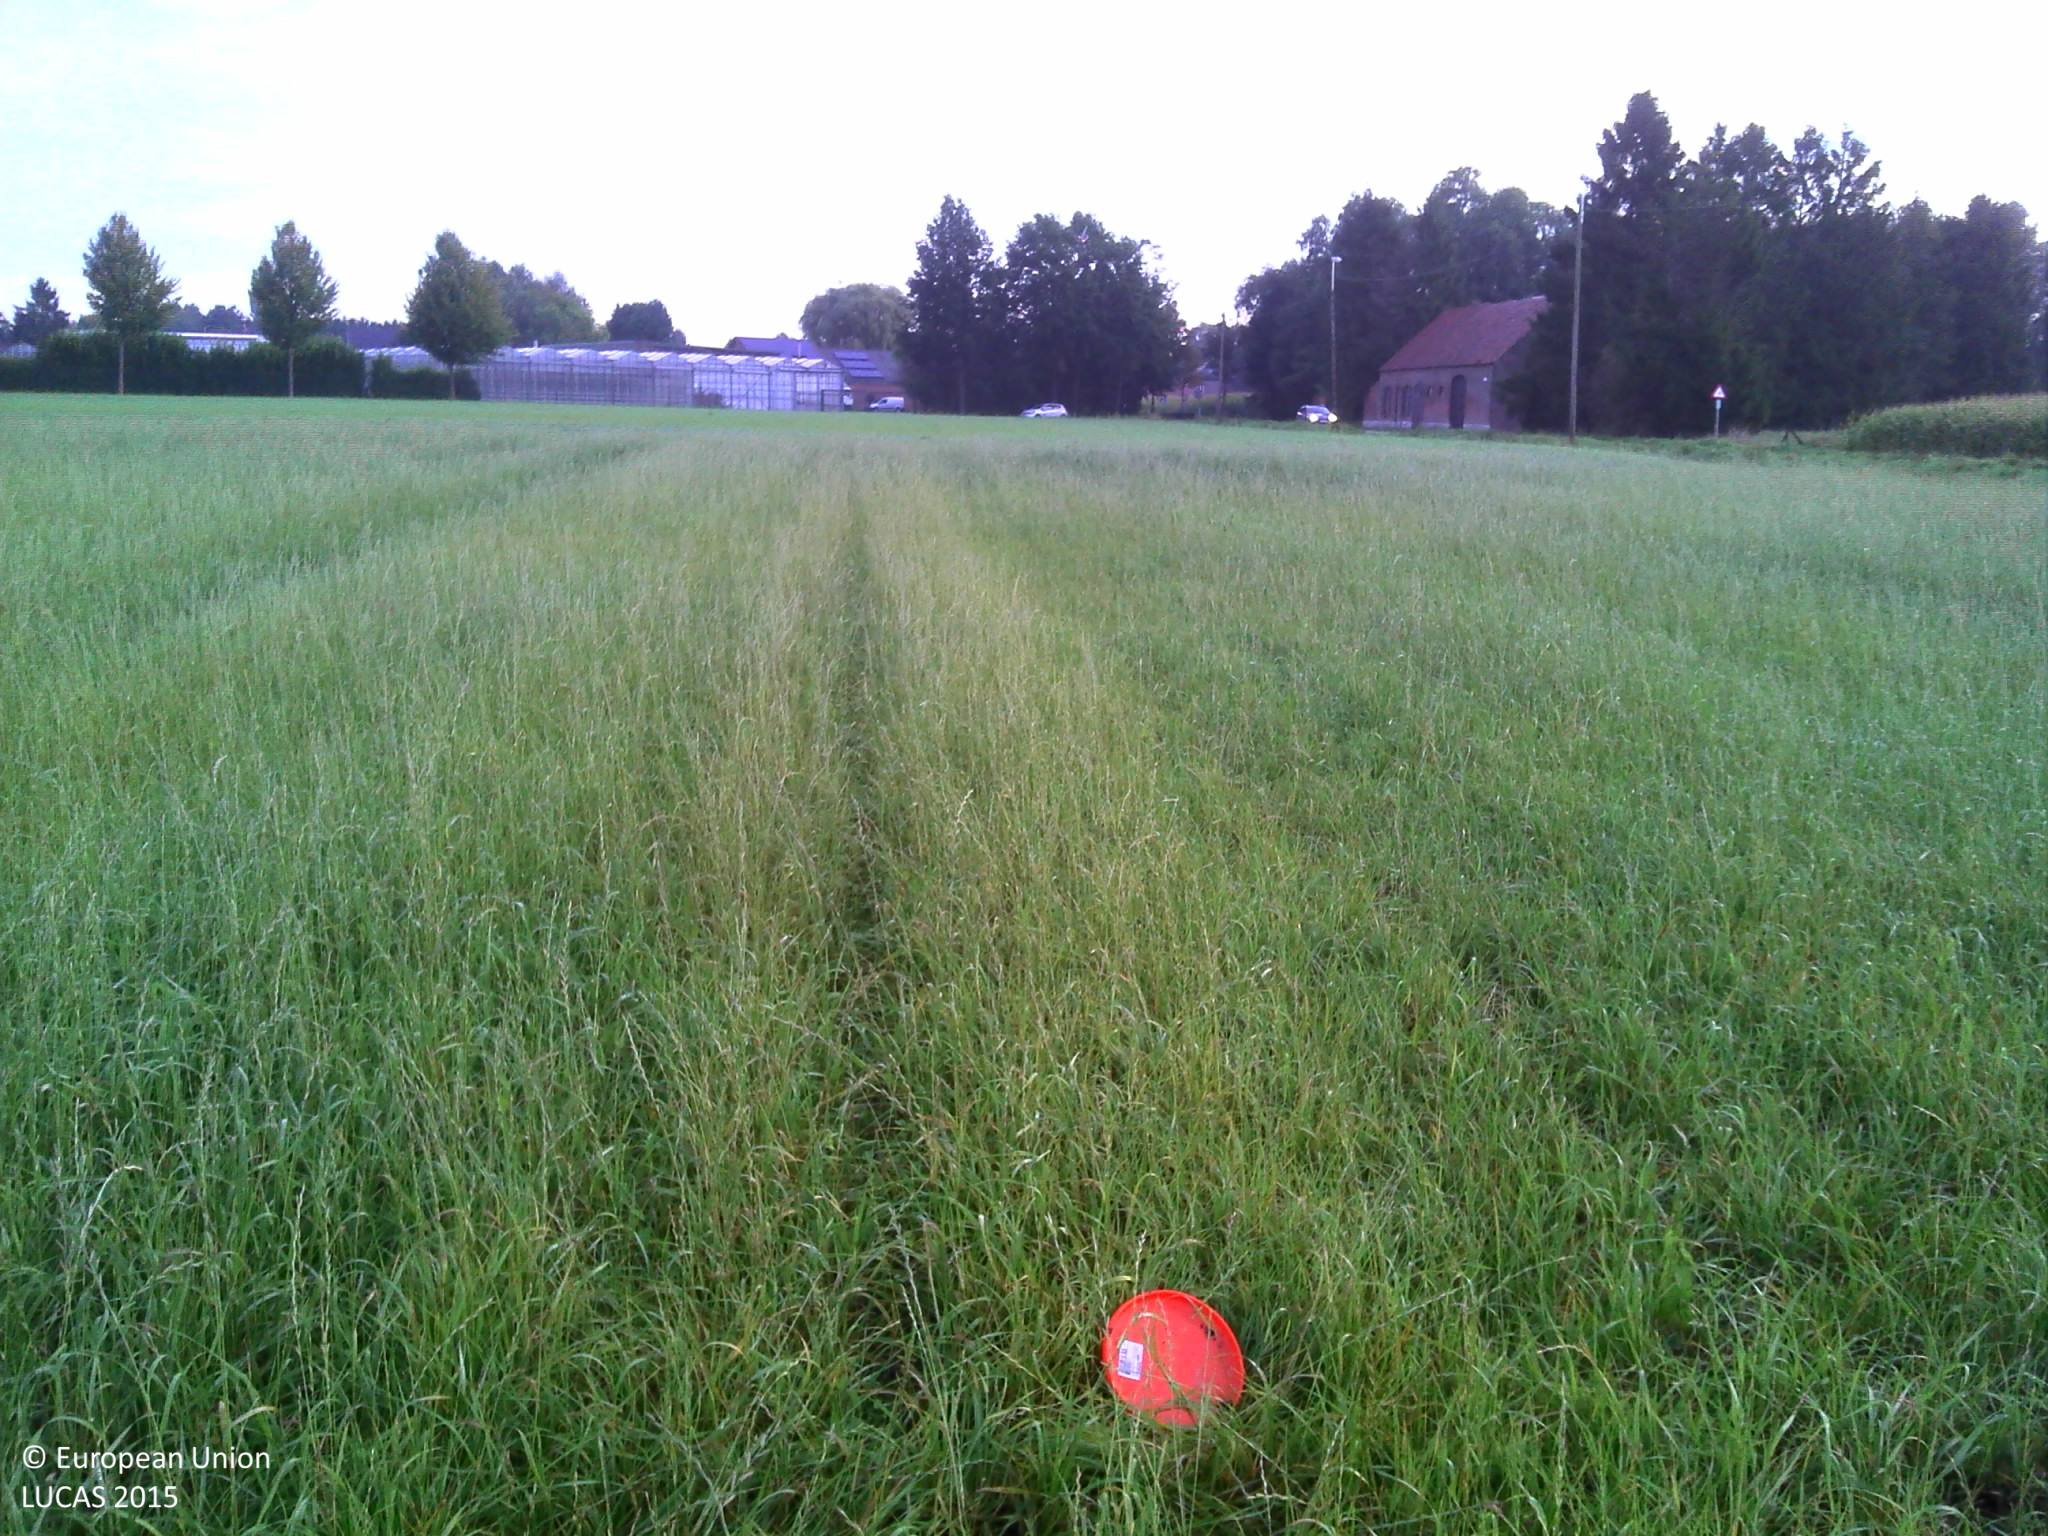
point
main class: Cropland
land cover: Temporary grasslands
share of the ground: > 75 %
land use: Agriculture (excluding fallow land and kitchen gardens)
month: September
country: BE
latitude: 51.0499
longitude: 4.2748
